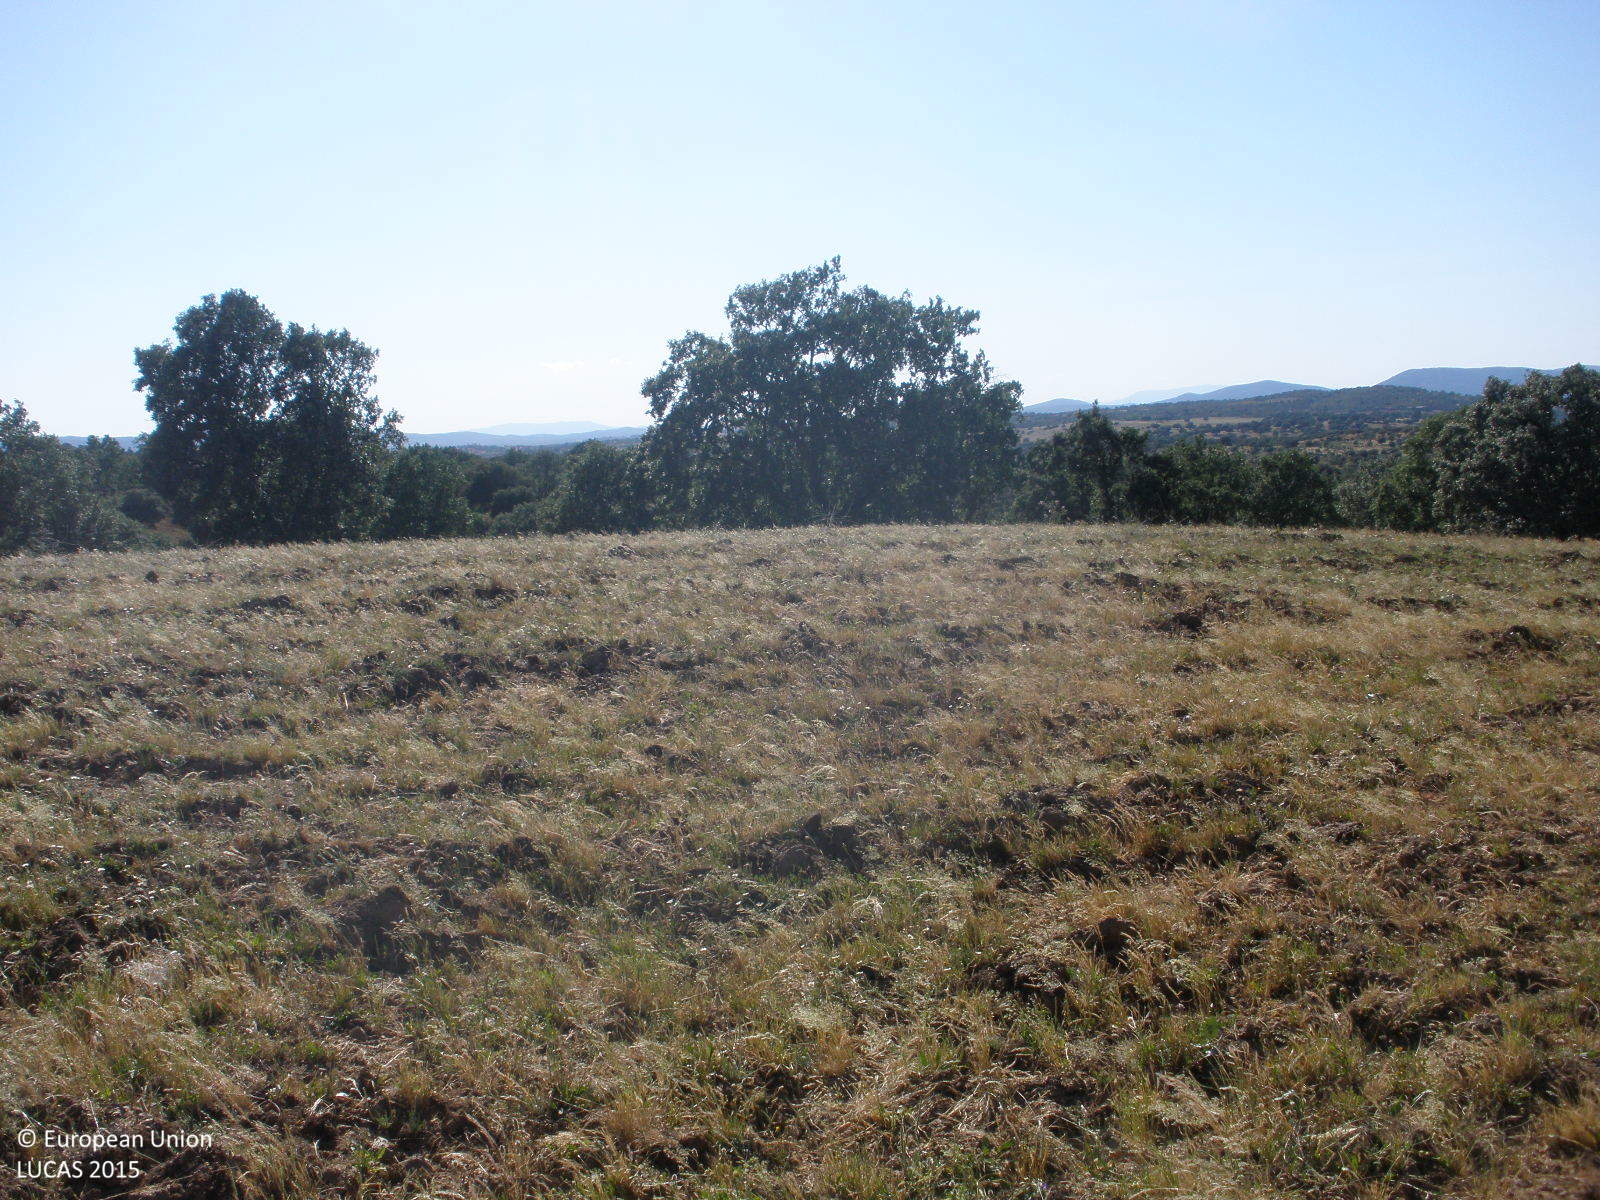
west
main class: Woodland
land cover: Broadleaved woodland
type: broadleaved evergreen forest
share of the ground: 25 - 50 %
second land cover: Spontaneously vegetated surfaces
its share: > 75 %
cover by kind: herbaceous plants 60 %, broadleaved forest trees 30 %, consolidated bare surface 10 %
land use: Forestry
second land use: Agriculture (excluding fallow land and kitchen gardens)
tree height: > 5 m
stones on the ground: 10 - 25 %
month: May
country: ES
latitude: 40.1279
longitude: -6.8350
